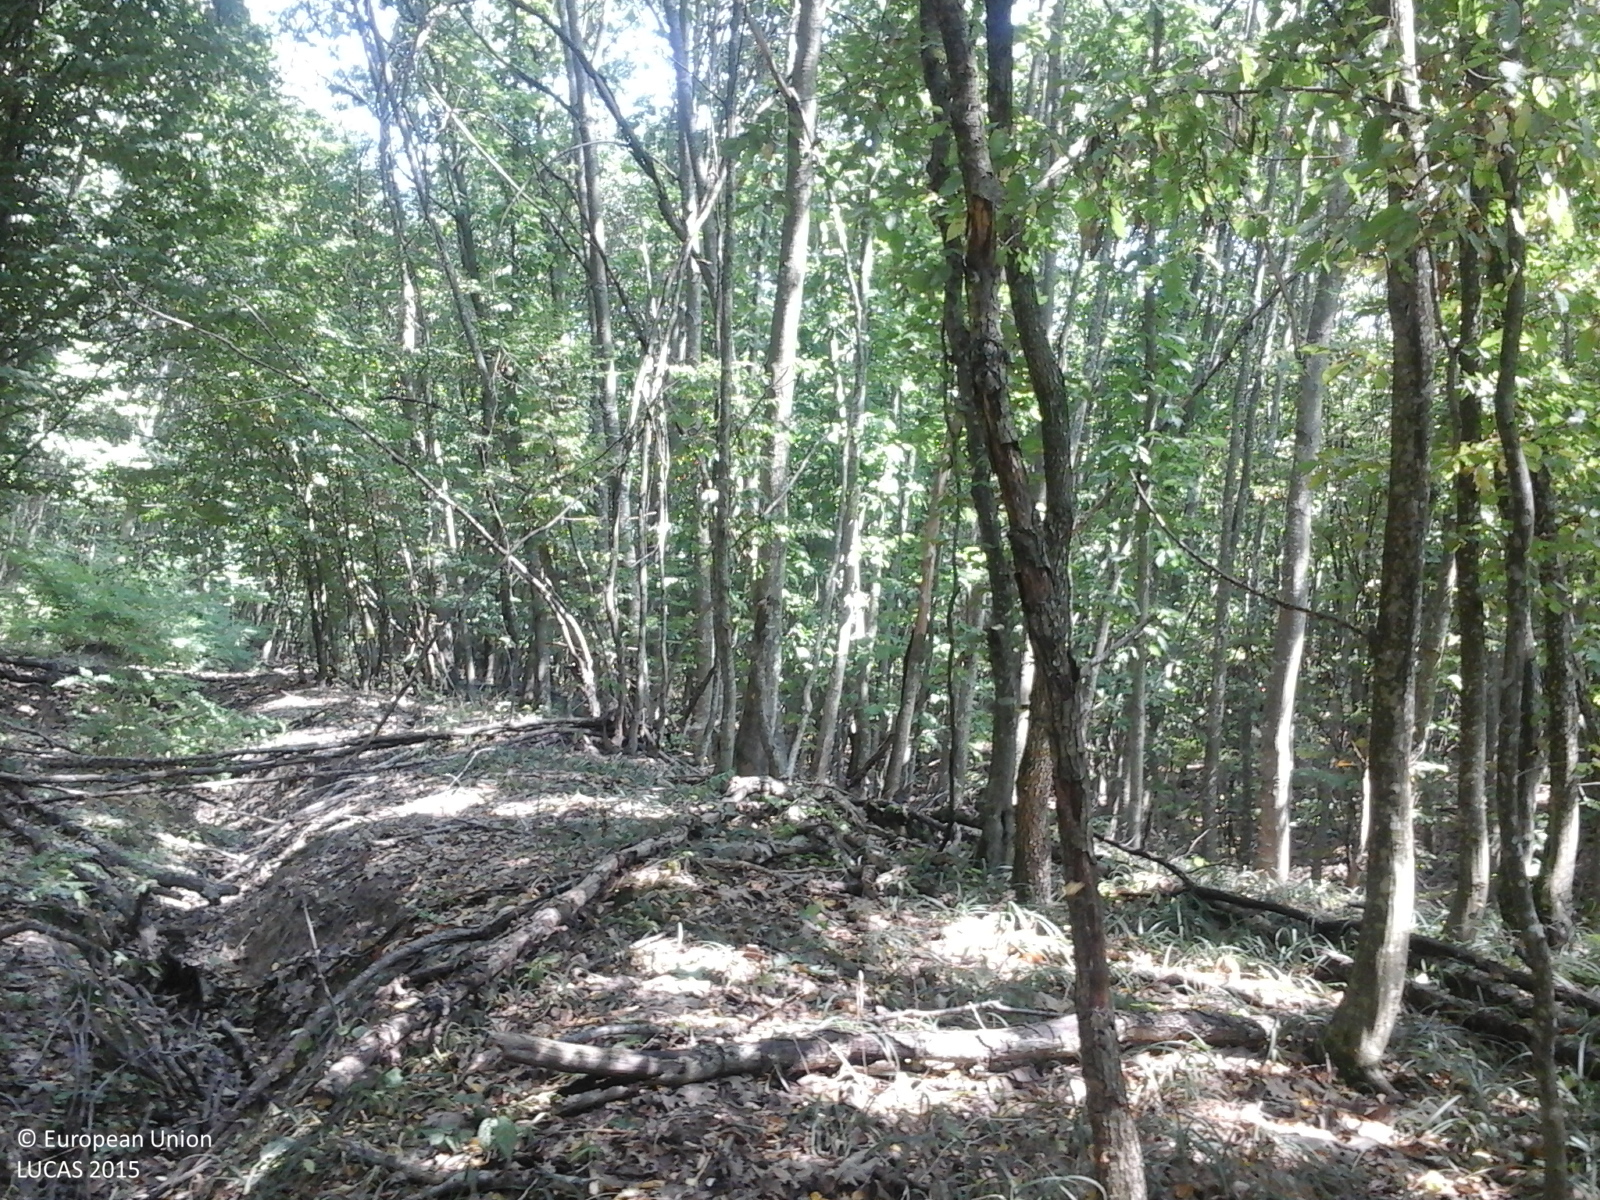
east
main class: Woodland
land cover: Broadleaved woodland
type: acidophilous oak and oak-birch forest
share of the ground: > 75 %
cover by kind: broadleaved forest trees 100 %
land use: Forestry
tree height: > 5 m
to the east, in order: Broadleaved woodland; Tracks; Broadleaved woodland
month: September
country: RO
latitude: 47.1088
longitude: 24.2520
